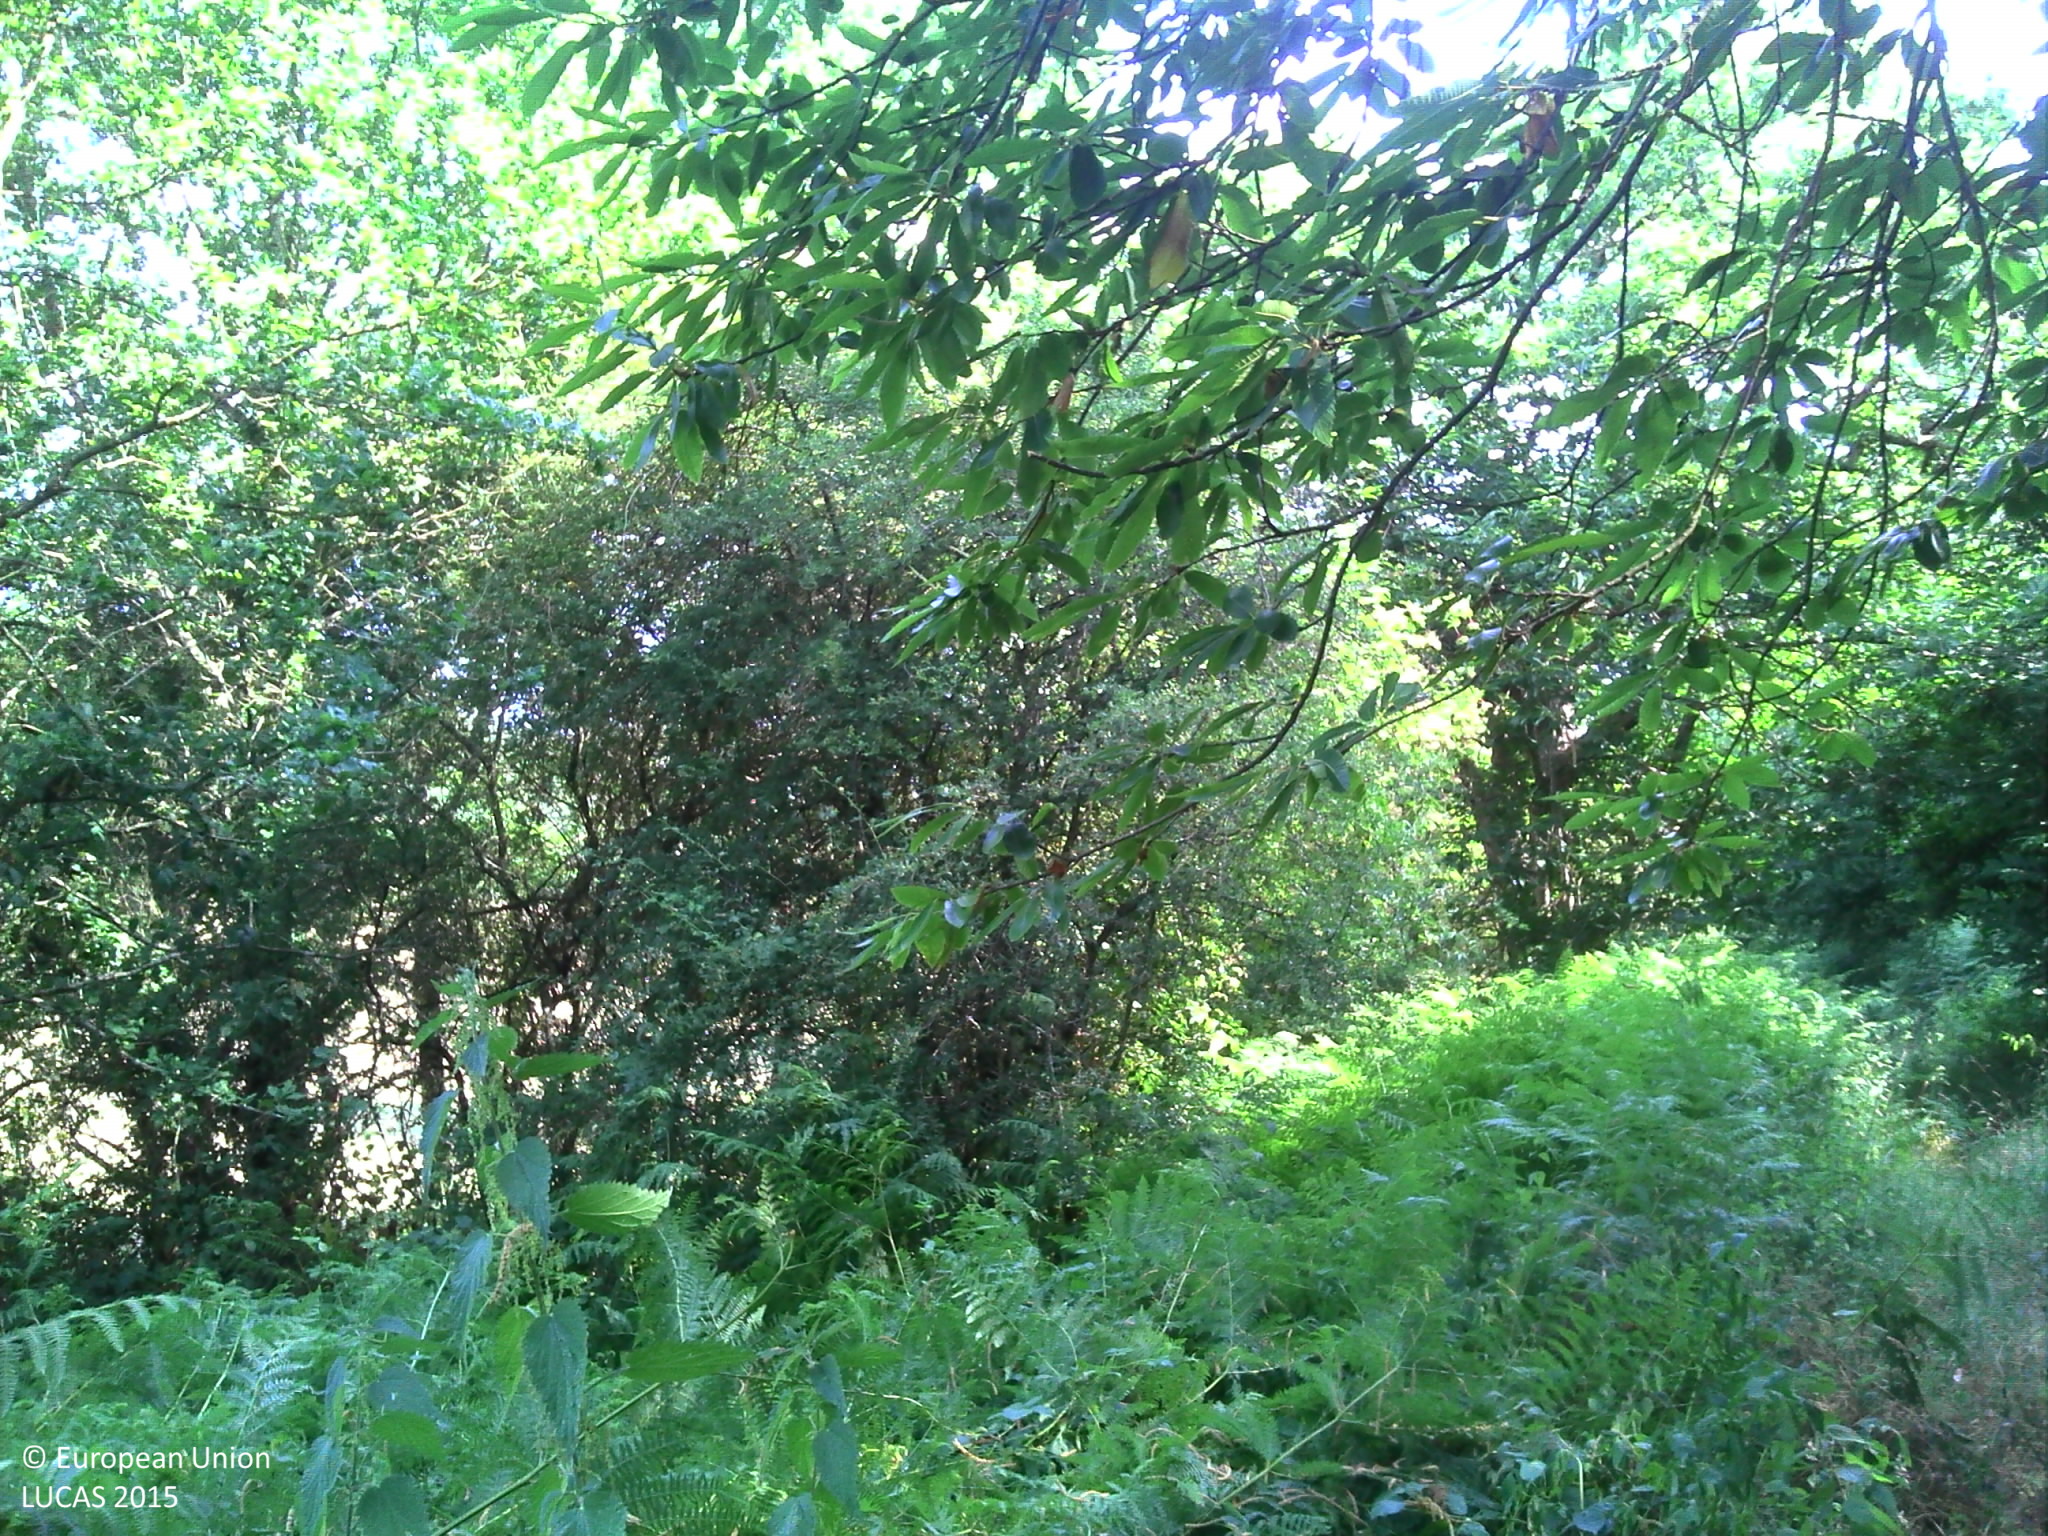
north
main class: Woodland
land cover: Broadleaved woodland
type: mesophytic deciduous forest
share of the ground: 50 - 75 %
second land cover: Spontaneously vegetated surfaces
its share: > 75 %
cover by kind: broadleaved forest trees 60 %, shrubs 30 %, herbaceous plants 10 %
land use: Forestry
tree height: > 5 m
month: July
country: FR
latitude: 47.7078
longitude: 0.3404
